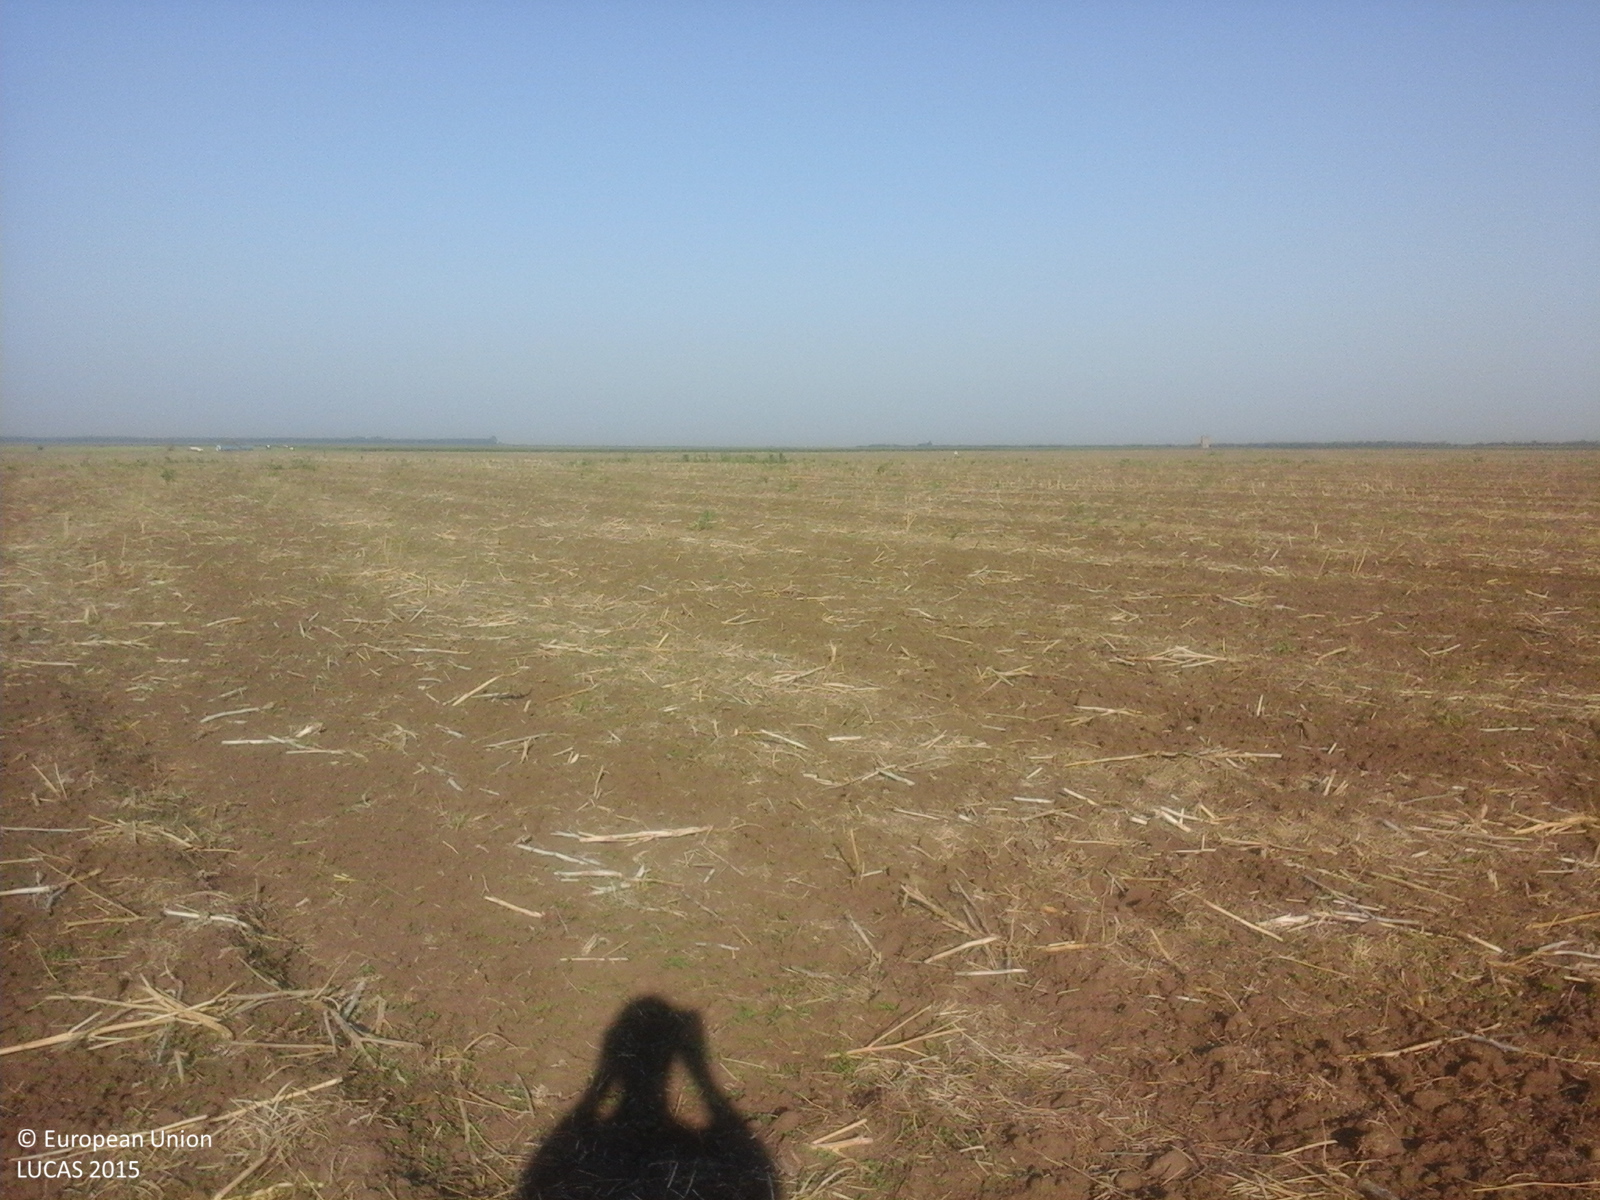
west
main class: Cropland
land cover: Rape and turnip rape
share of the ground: < 10 %
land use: Agriculture (excluding fallow land and kitchen gardens)
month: July
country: RO
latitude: 44.3874
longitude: 27.5540
